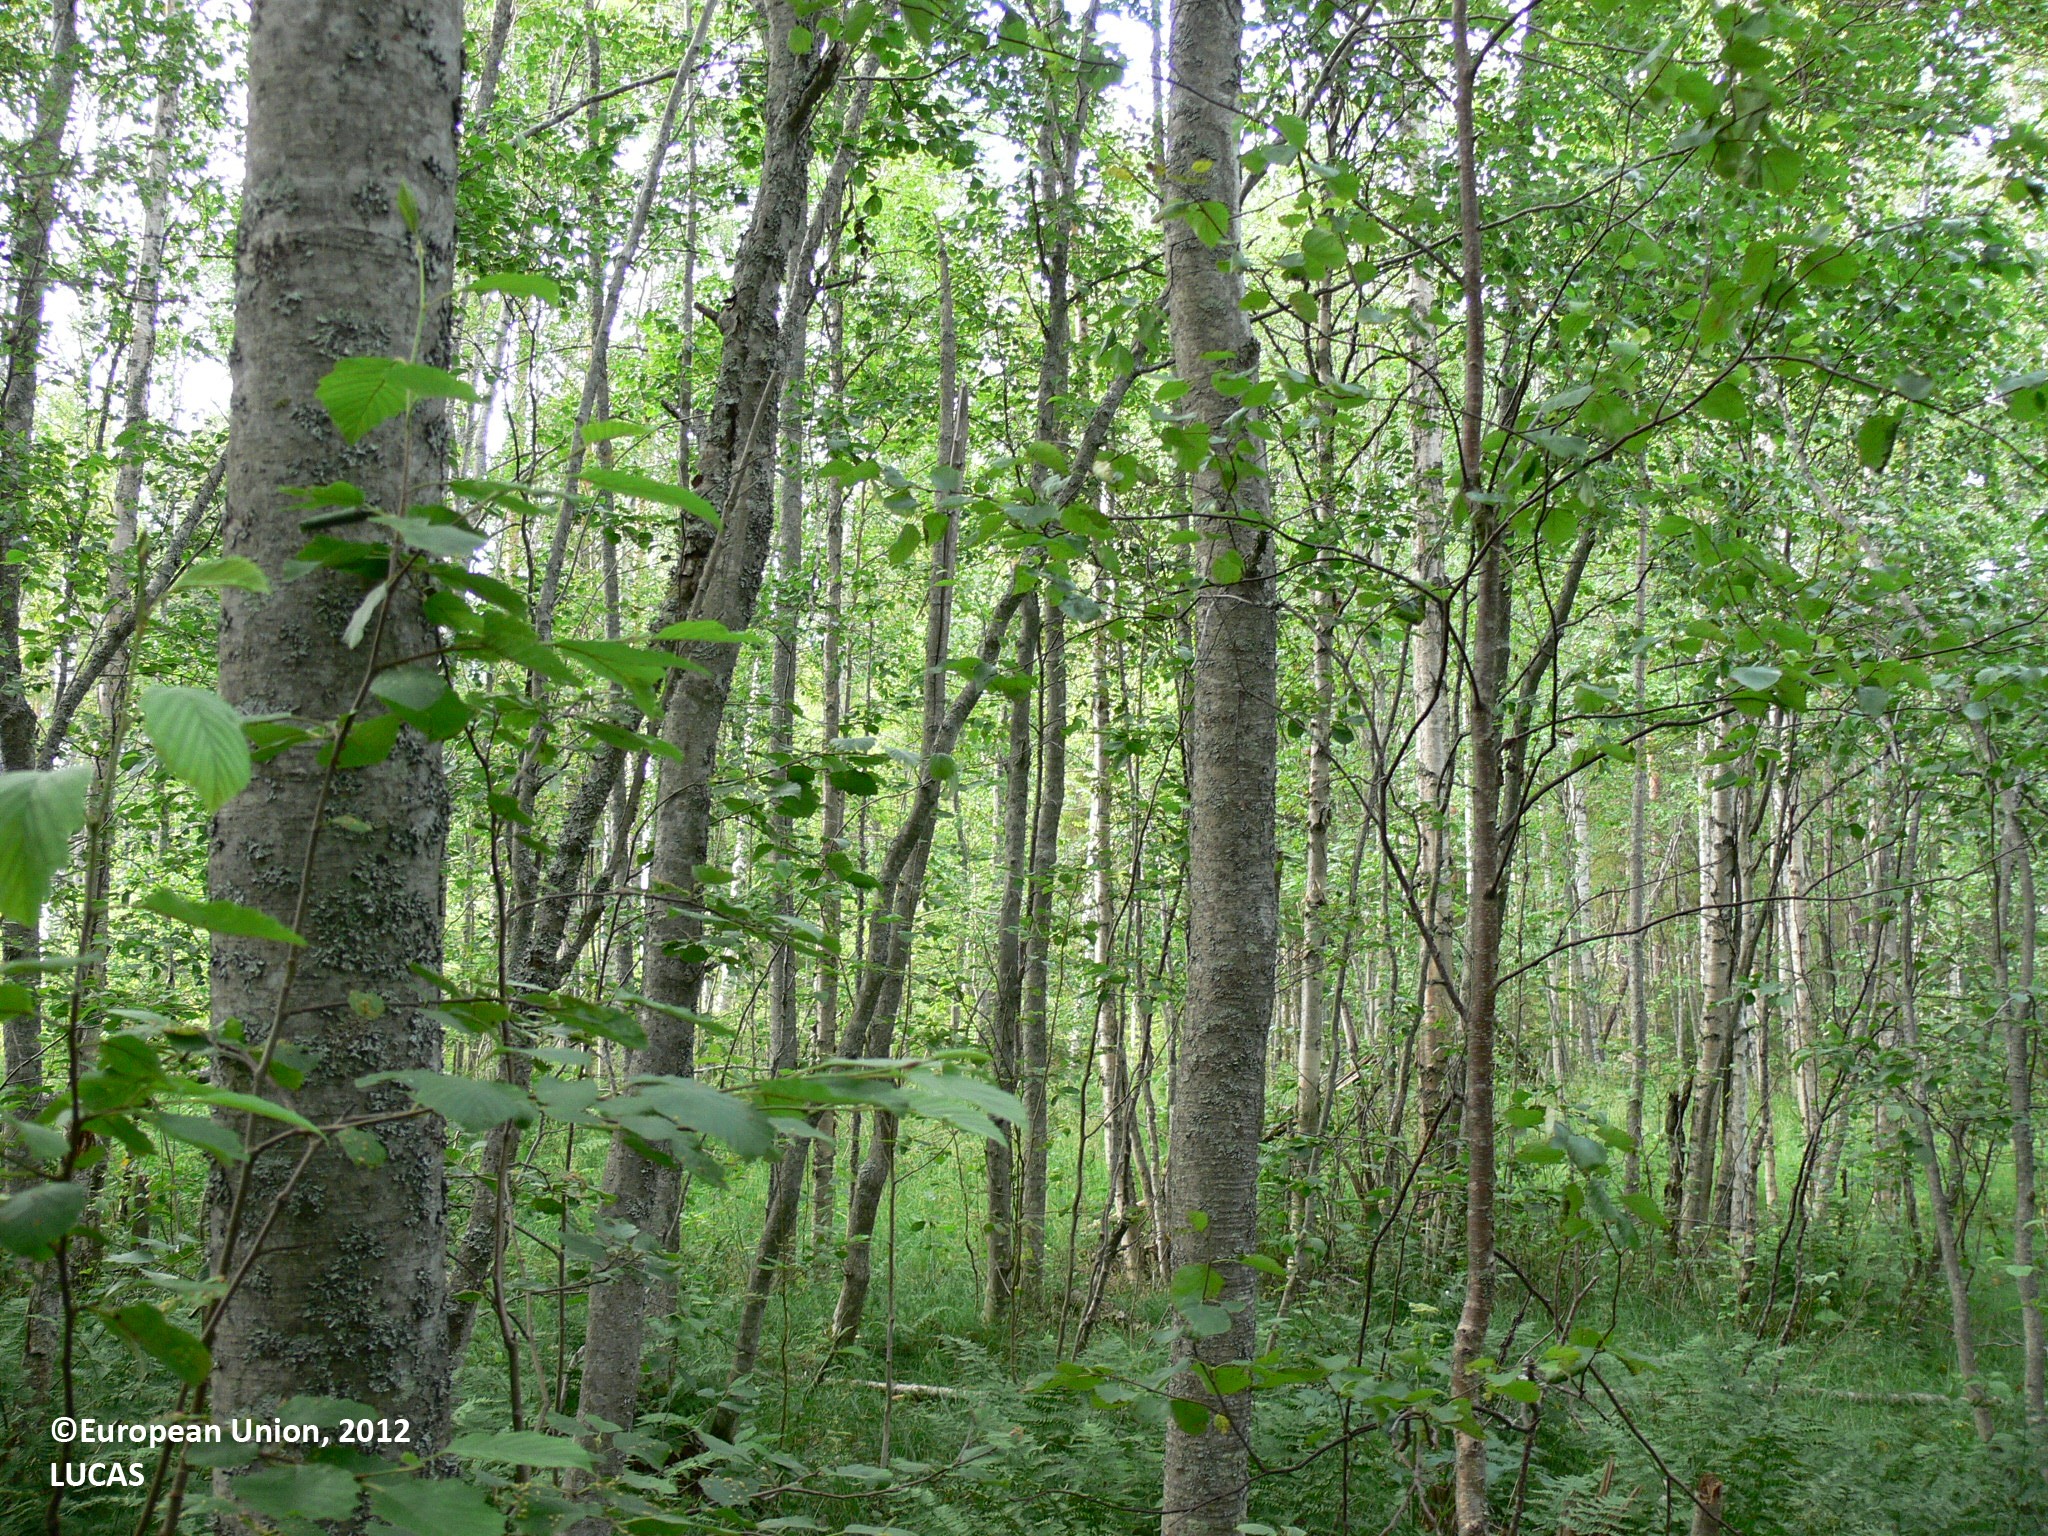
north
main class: Woodland
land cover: Other mixed woodland
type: boreal forest
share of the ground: > 75 %
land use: Forestry
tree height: > 5 m
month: July
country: FI
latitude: 63.1831
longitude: 29.5242
